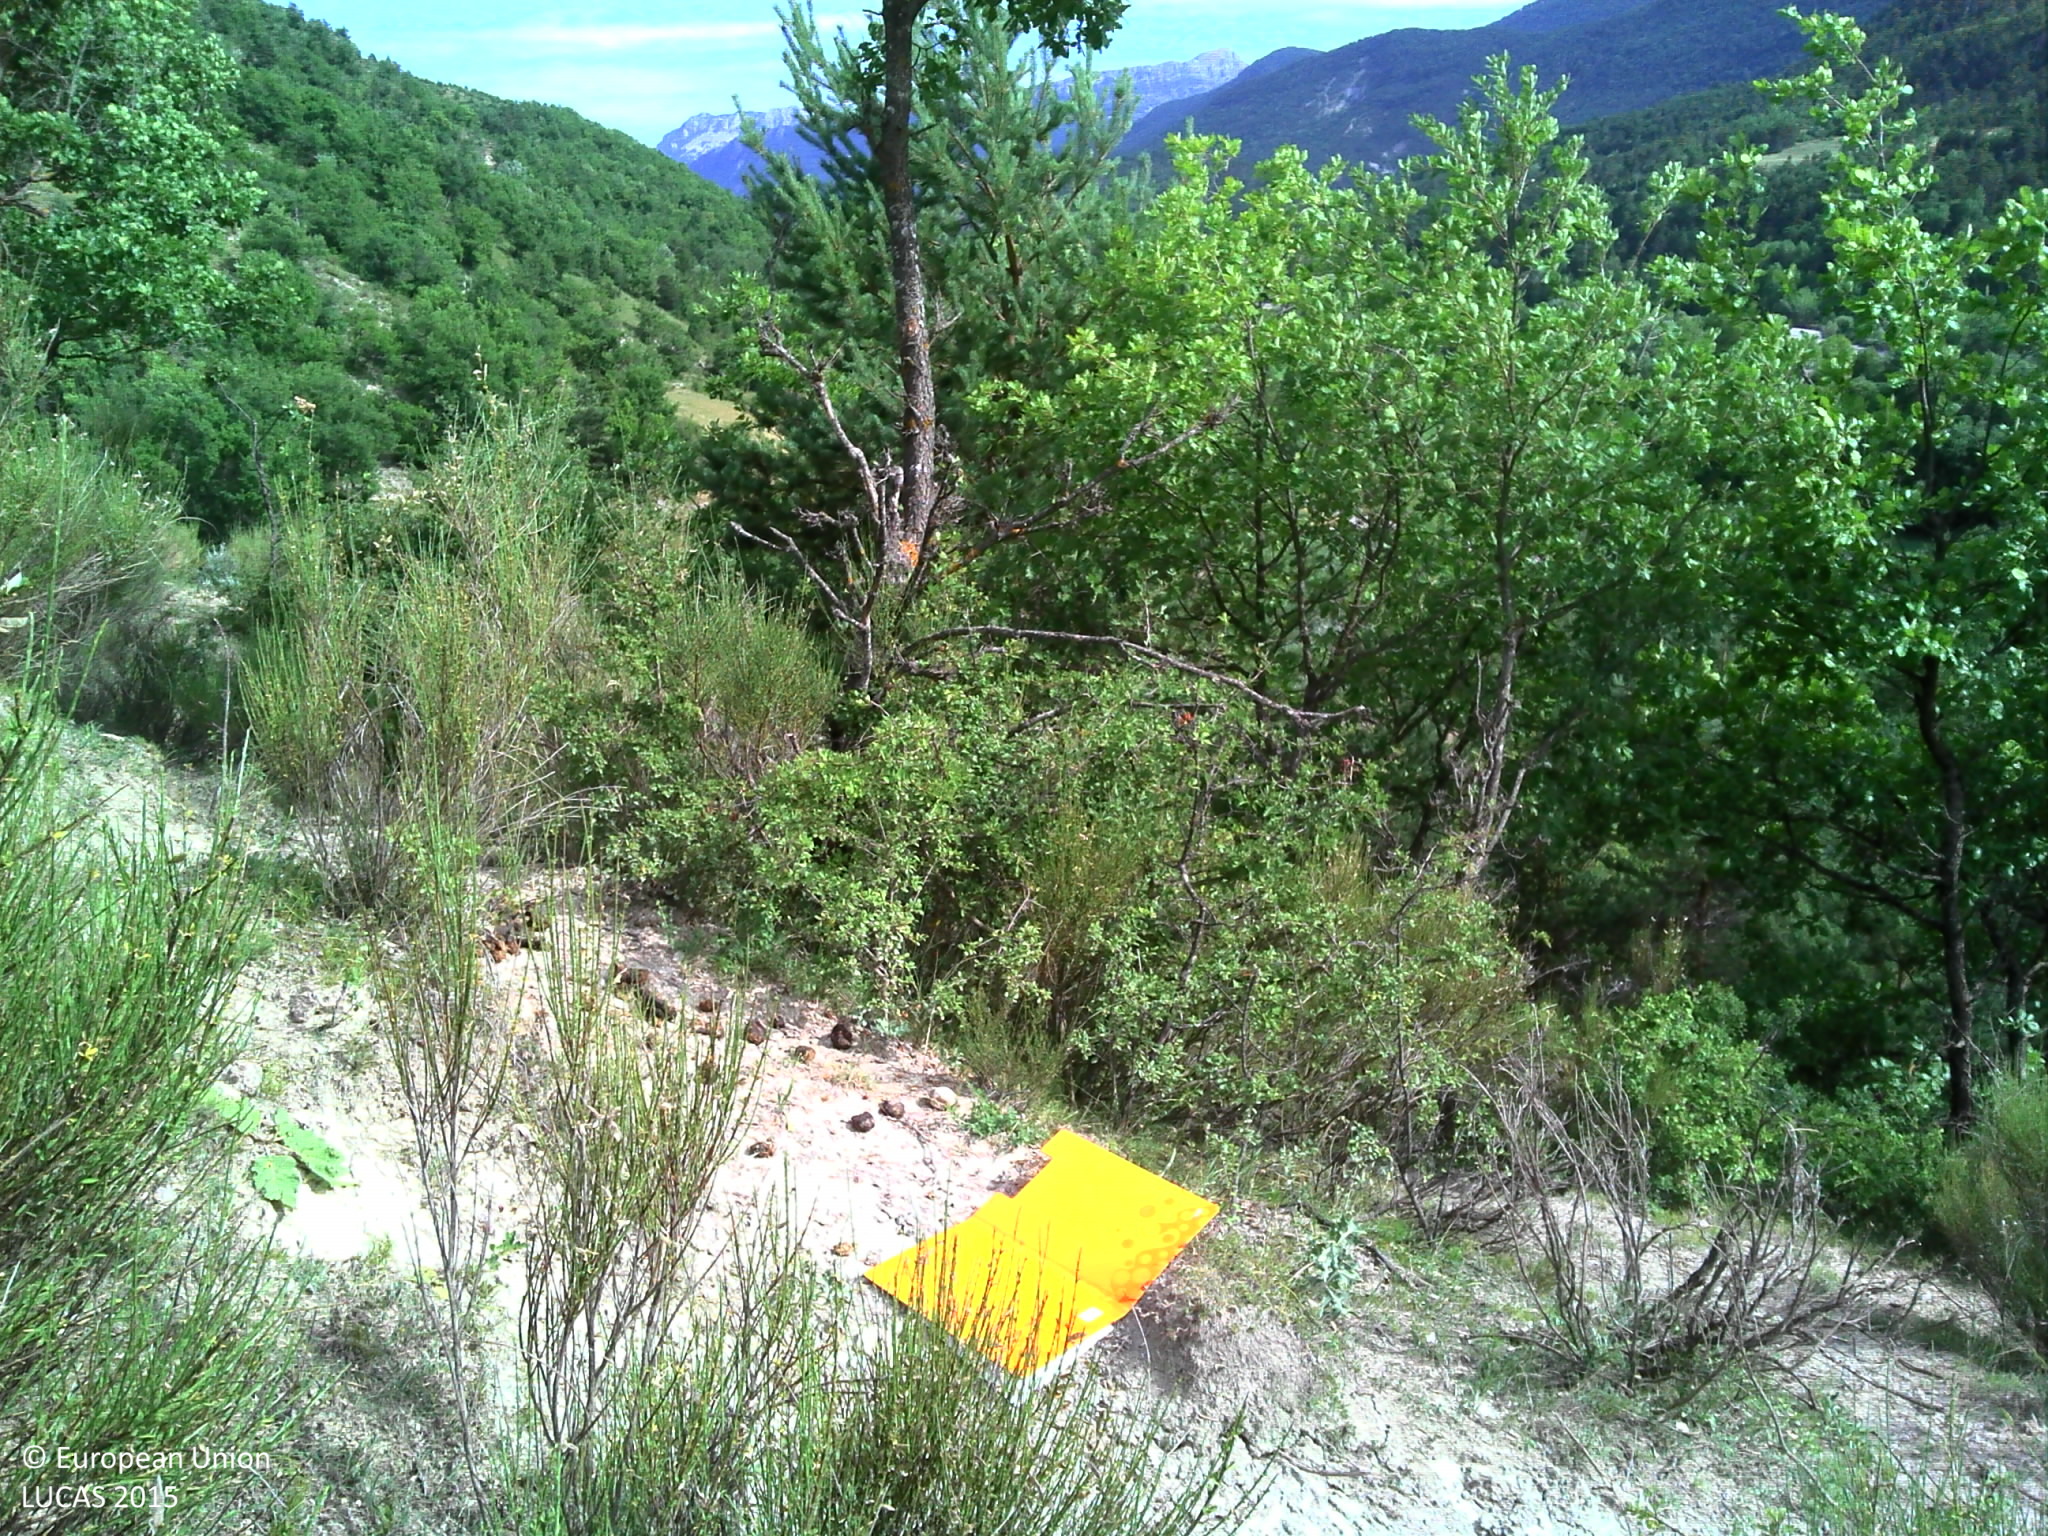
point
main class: Shrubland
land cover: Shrubland with sparse tree cover
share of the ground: > 75 %
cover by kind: shrubs 50 %, consolidated bare surface 35 %, herbaceous plants 10 %, broadleaved forest trees 5 %
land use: Agriculture (excluding fallow land and kitchen gardens)
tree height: > 5 m
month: July
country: FR
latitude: 43.9445
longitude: 6.3820
